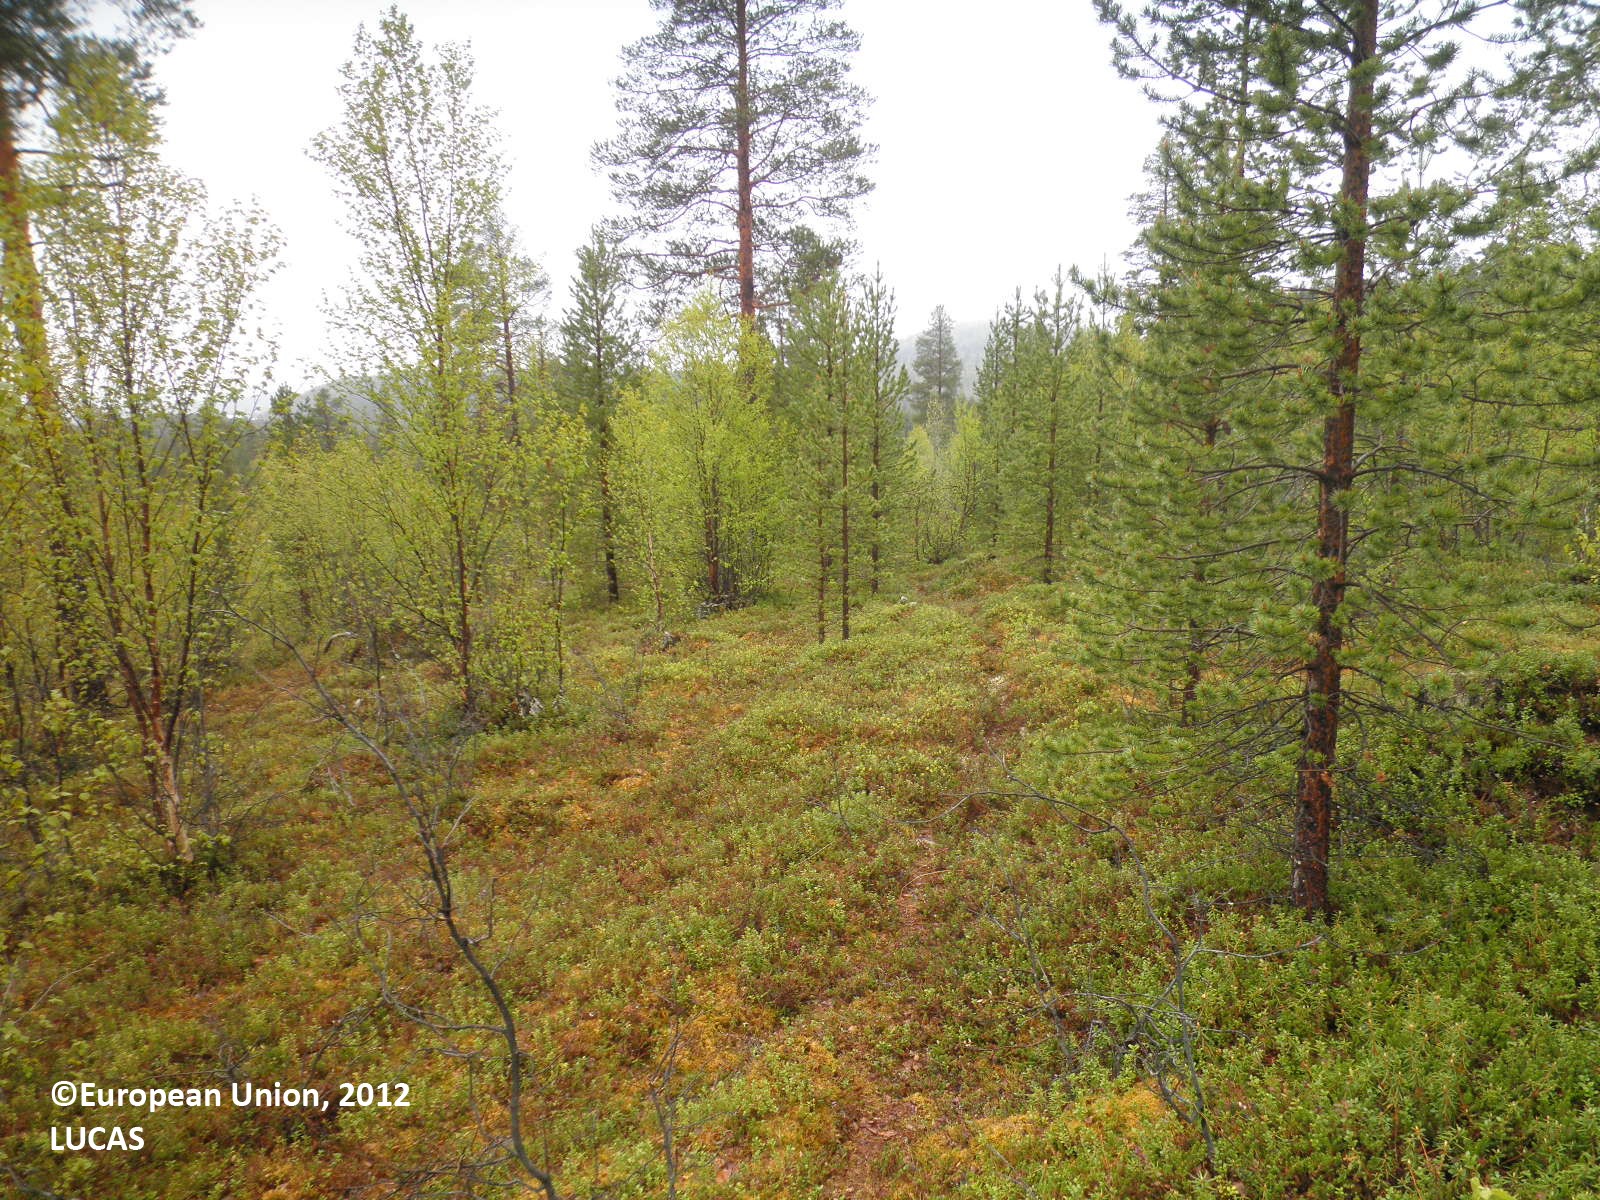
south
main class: Woodland
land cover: Pine dominated mixed woodland
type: boreal forest
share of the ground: 50 - 75 %
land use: Forestry
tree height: > 5 m
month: June
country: FI
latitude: 68.7940
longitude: 27.8459
